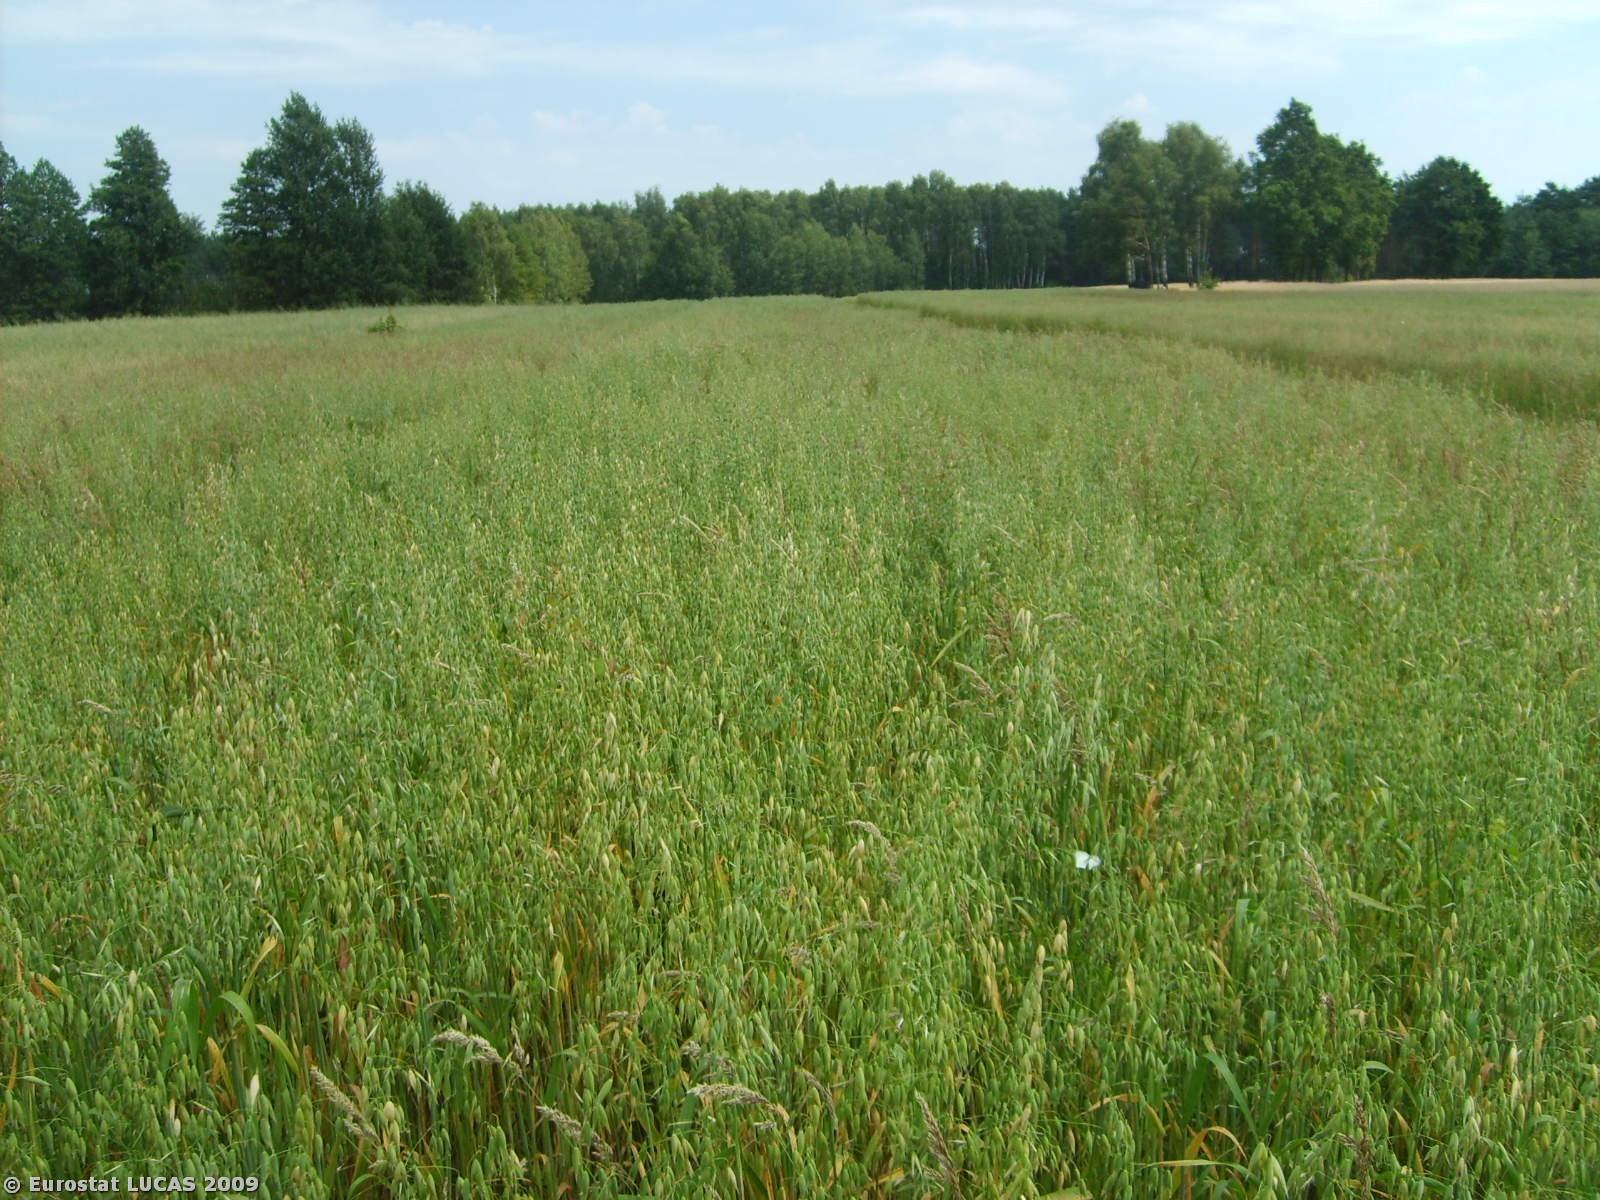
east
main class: Cropland
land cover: Oats
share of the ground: > 75 %
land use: Agriculture (excluding fallow land and kitchen gardens)
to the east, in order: Oats; Grass margins; Tracks; Grass margins; Oats; Grassland without tree/shrub cover
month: July
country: PL
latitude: 52.4544
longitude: 21.6638
